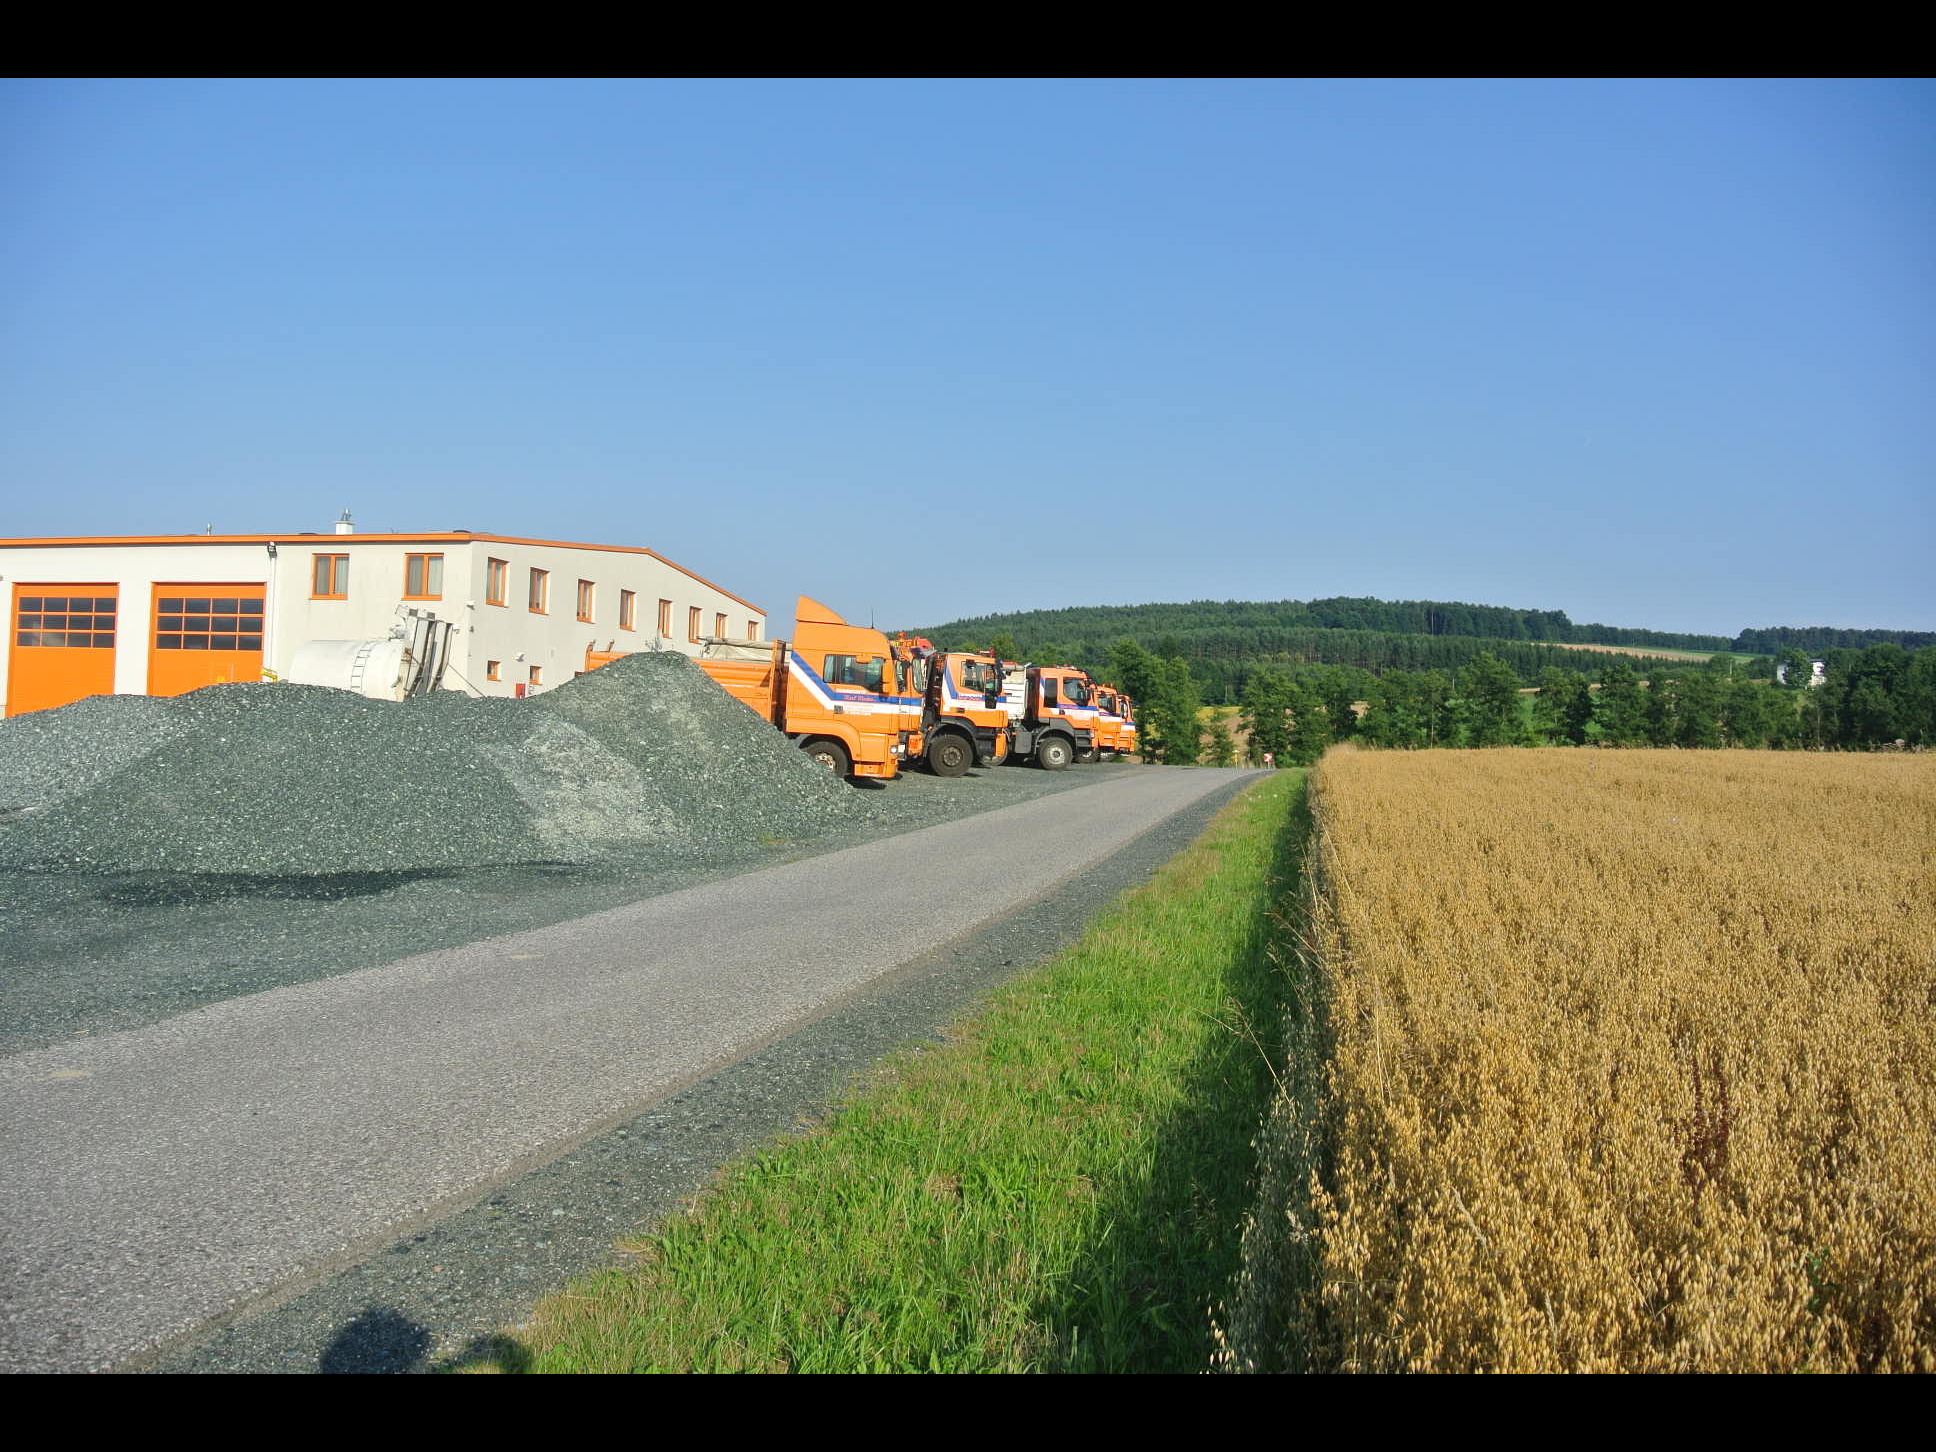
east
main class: Cropland
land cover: Oats
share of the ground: > 75 %
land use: Agriculture (excluding fallow land and kitchen gardens)
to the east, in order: Oats; Electric lines; Oats; Grass margins; Artificial constructions in urban areas; Grassland without tree/shrub cover; Paved roads, cycling and walking lanes; Grass margins; Common wheat
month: July
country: AT
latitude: 47.4070
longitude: 16.3773
